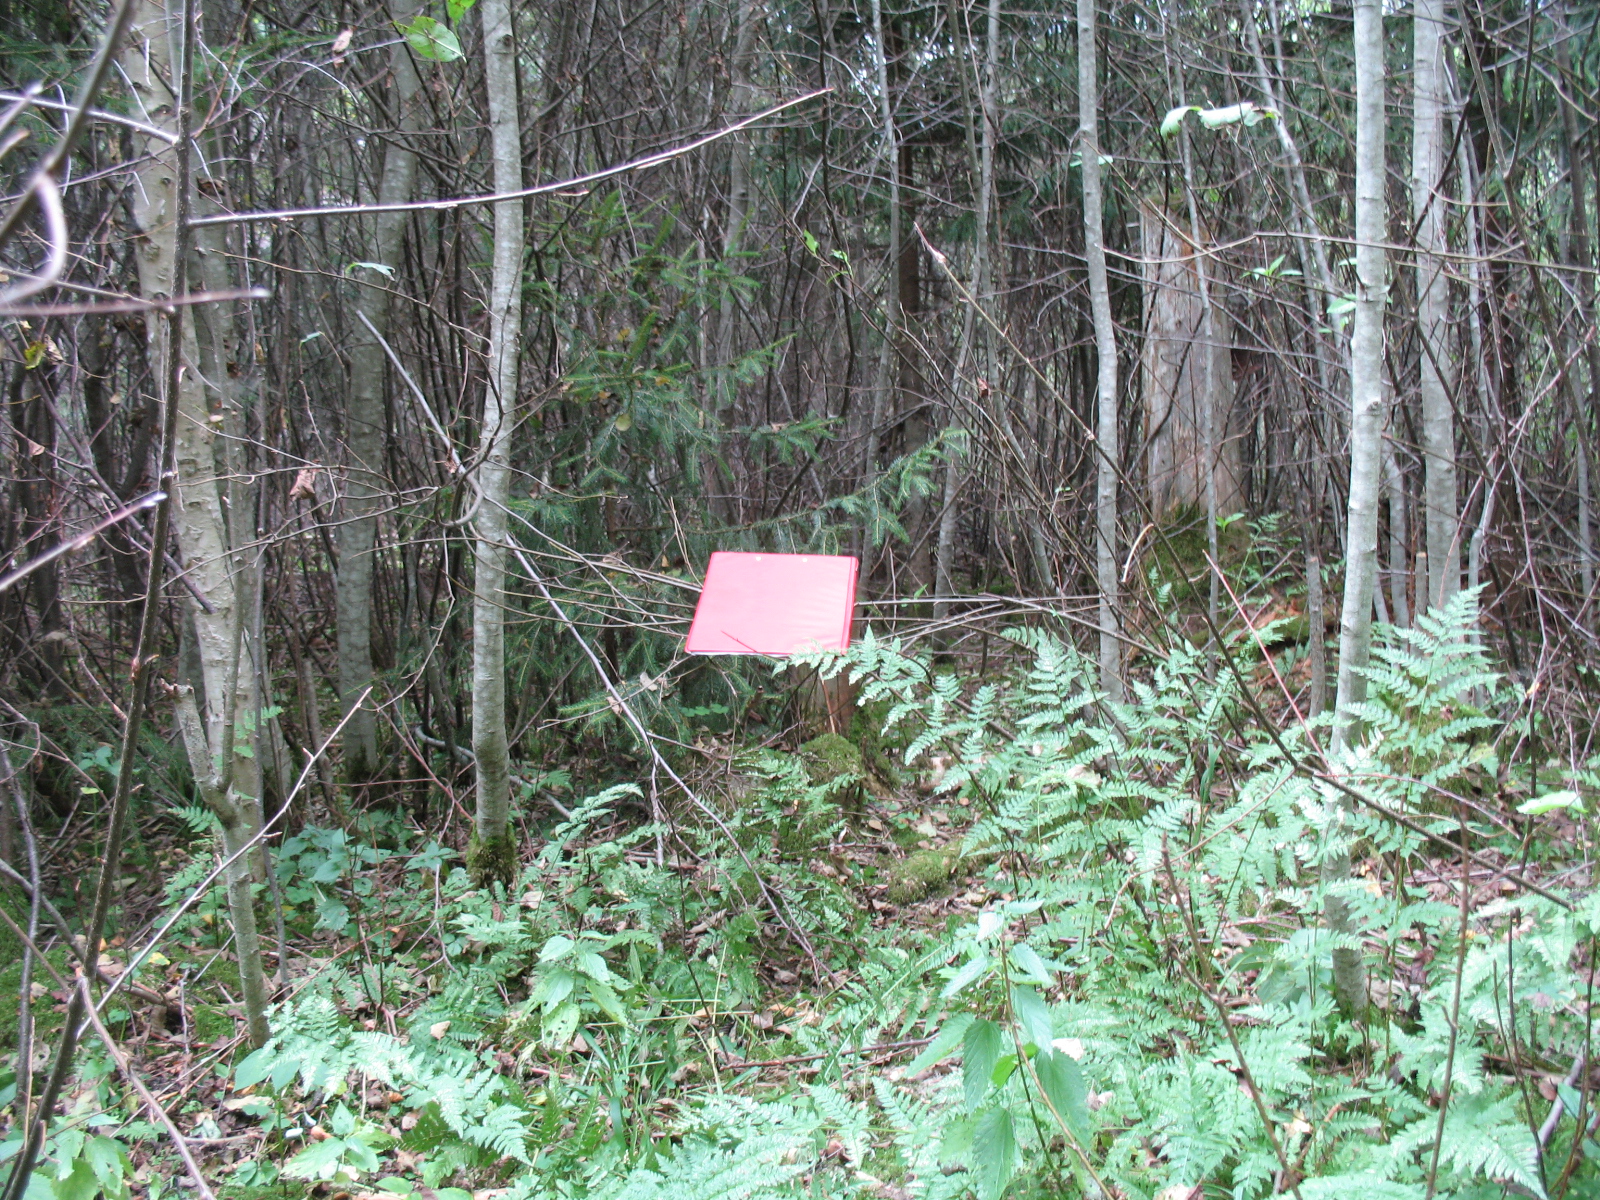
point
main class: Woodland
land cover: Broadleaved woodland
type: non-riverine alder, birch or aspen forest
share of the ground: > 75 %
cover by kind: broadleaved forest trees 80 %, coniferous forest trees 10 %, herbaceous plants 5 %, lichens and mosses 5 %
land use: Forestry
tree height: > 5 m
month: August
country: LV
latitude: 56.2779
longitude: 25.5465
